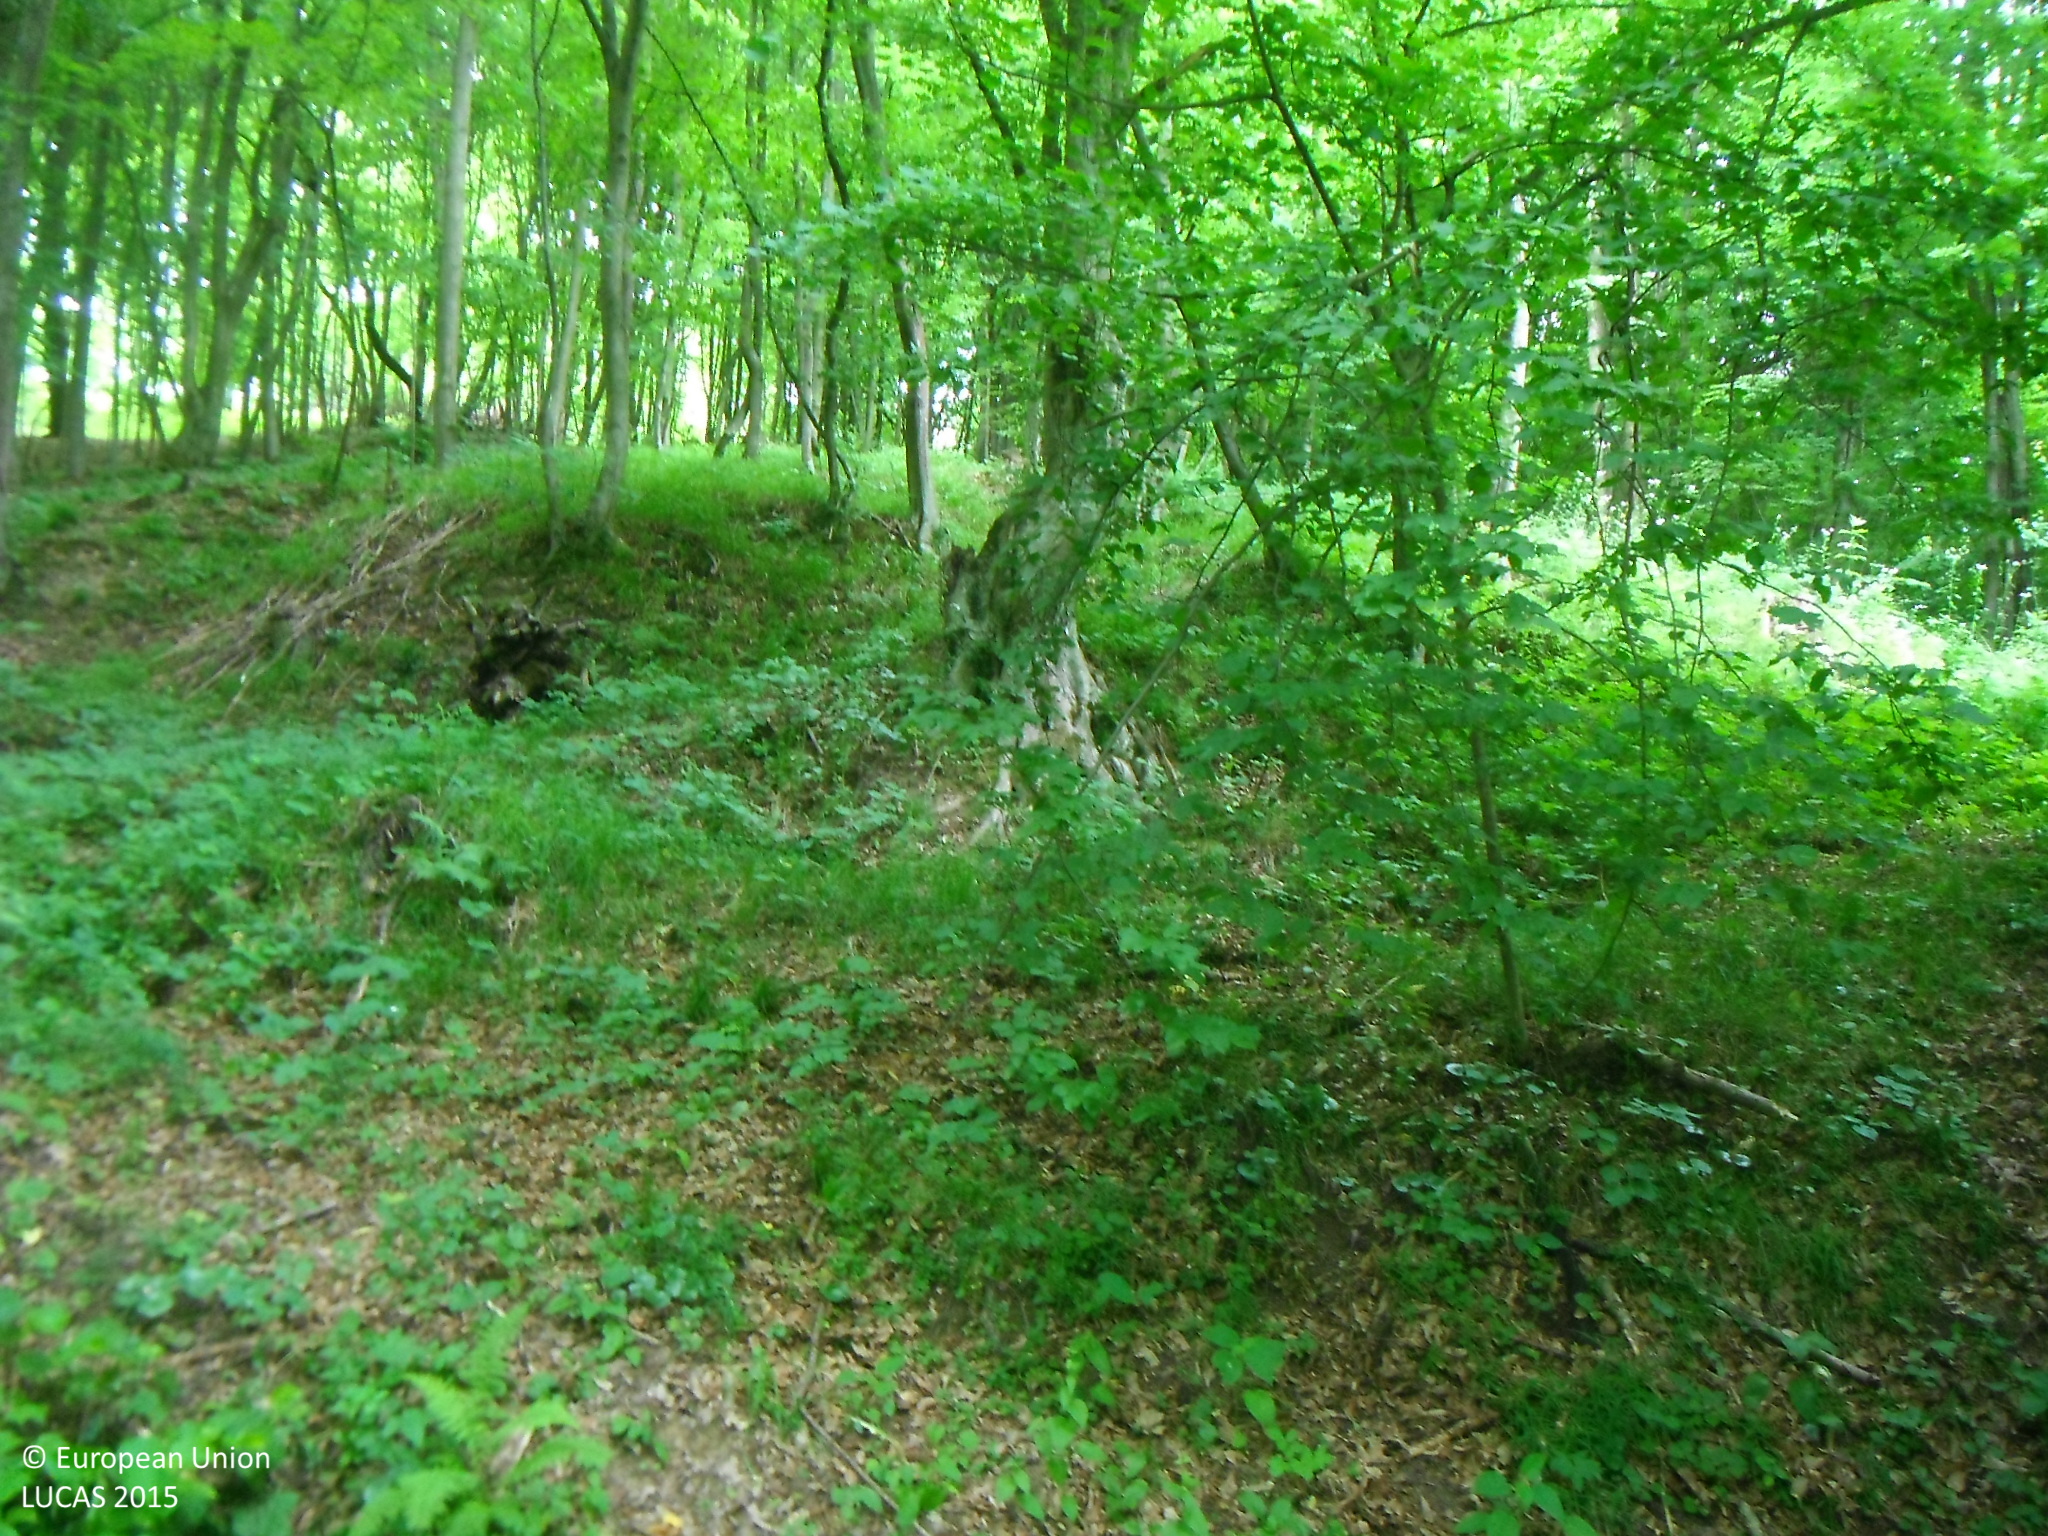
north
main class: Woodland
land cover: Broadleaved woodland
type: beech forest
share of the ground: > 75 %
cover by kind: broadleaved forest trees 90 %, herbaceous plants 5 %, consolidated bare surface 5 %
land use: Forestry
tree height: > 5 m
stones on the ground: < 10 %
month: June
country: SK
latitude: 48.9915
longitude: 21.9307
